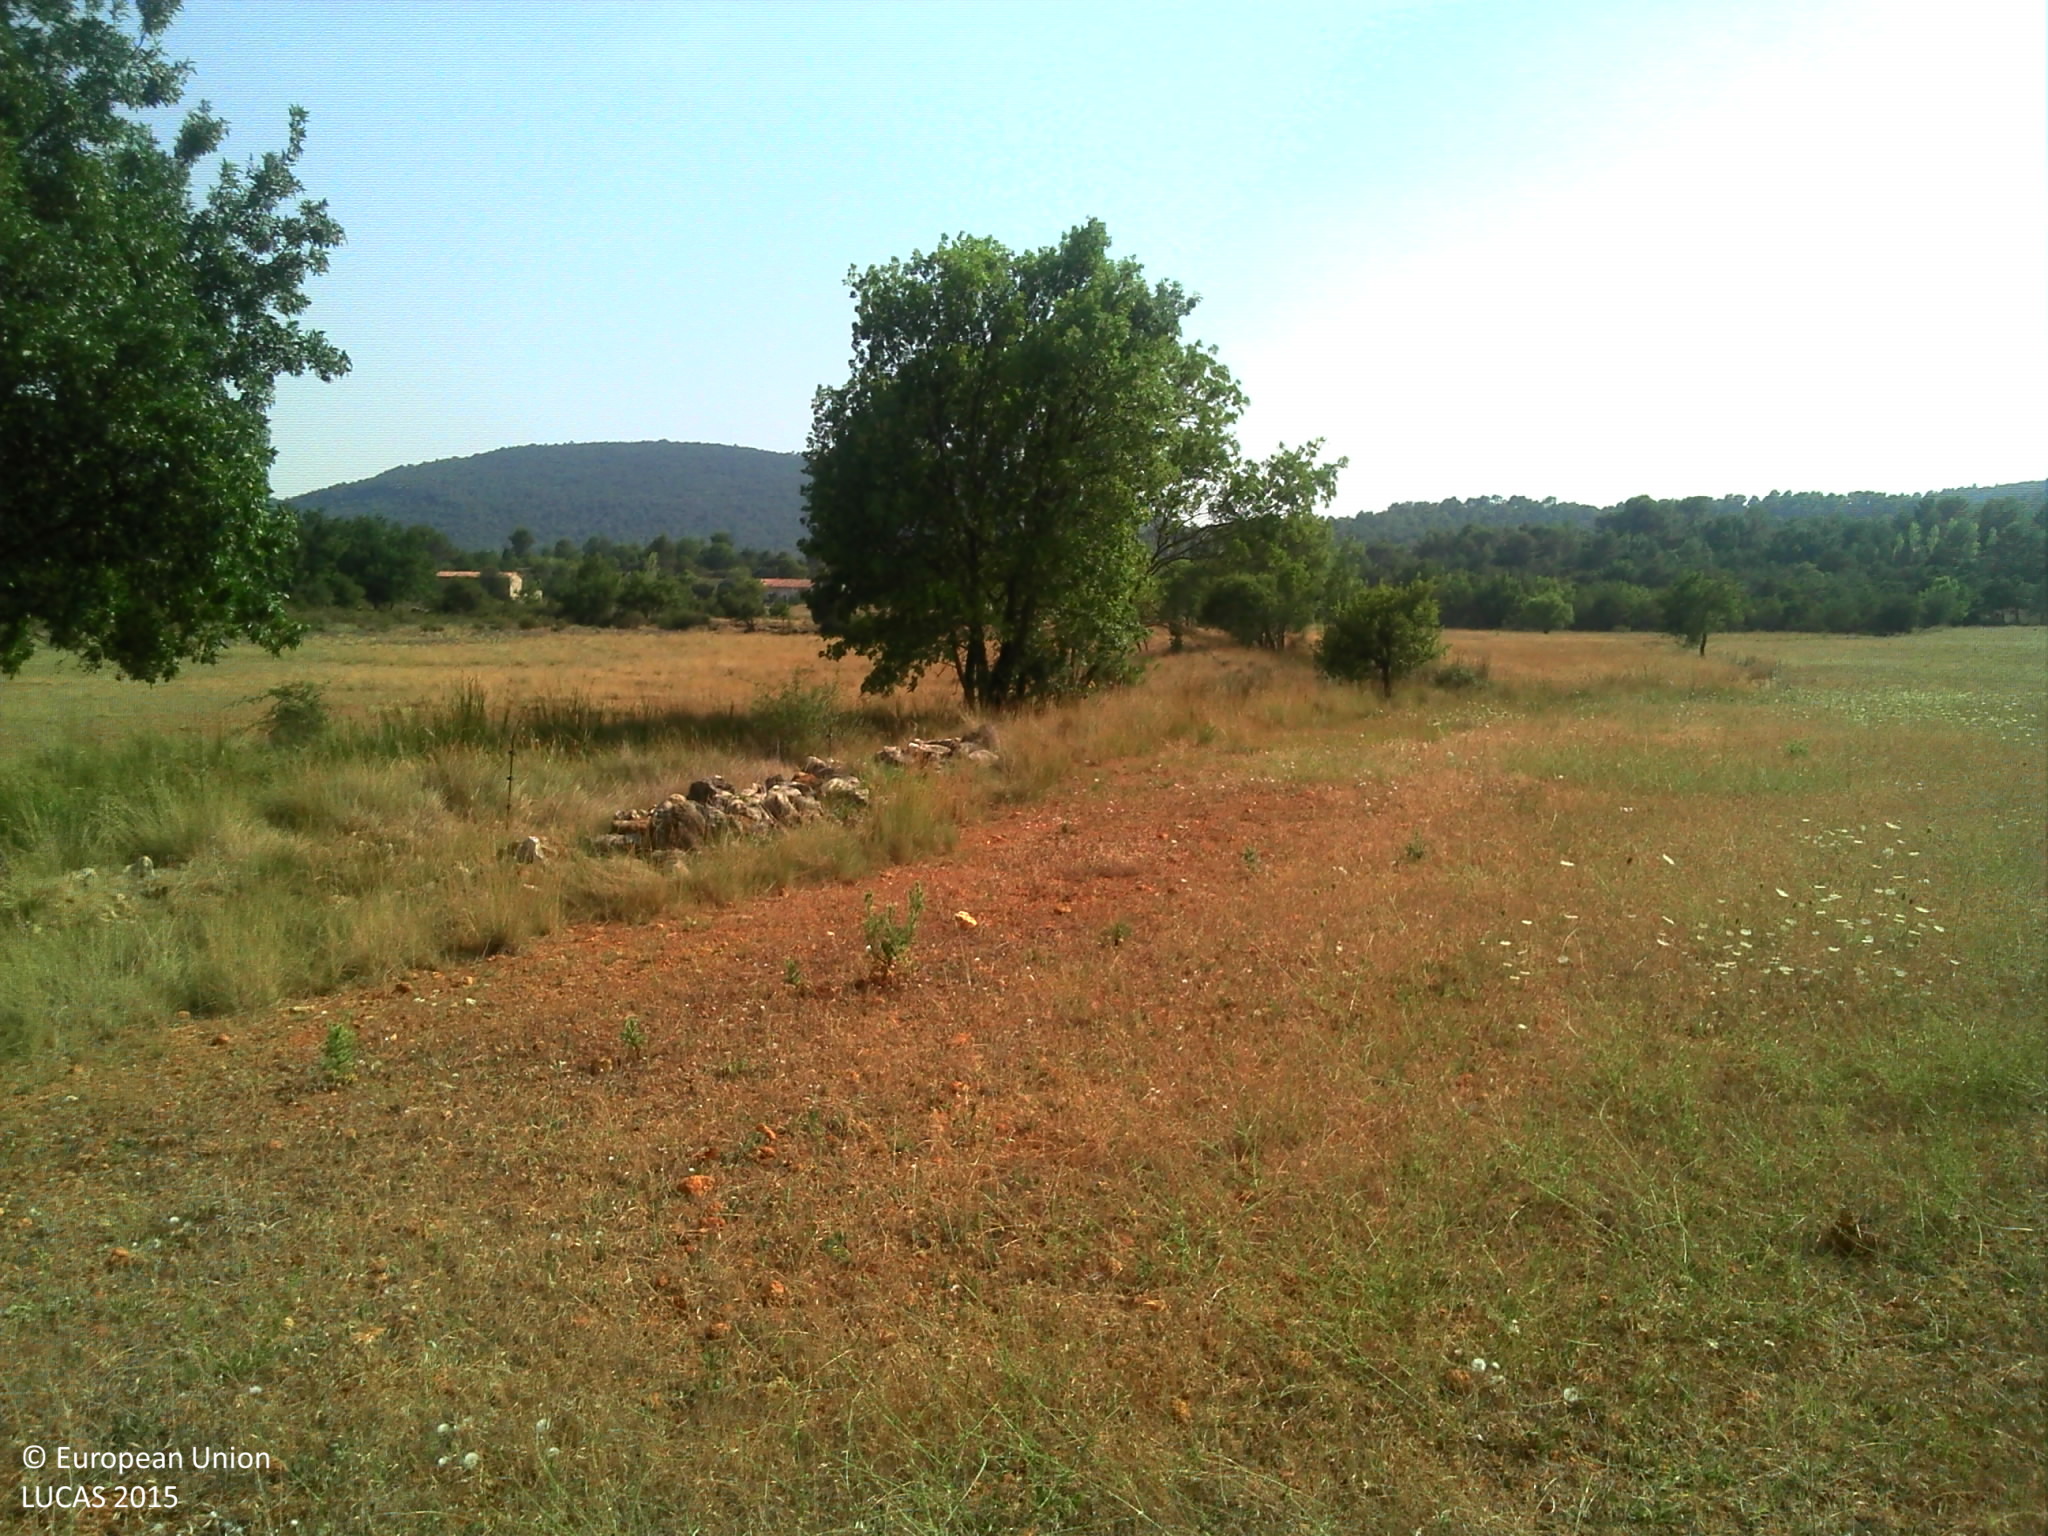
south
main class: Cropland
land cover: Temporary grasslands
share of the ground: > 75 %
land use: Agriculture (excluding fallow land and kitchen gardens)
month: August
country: FR
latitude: 43.6183
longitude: 6.3529
